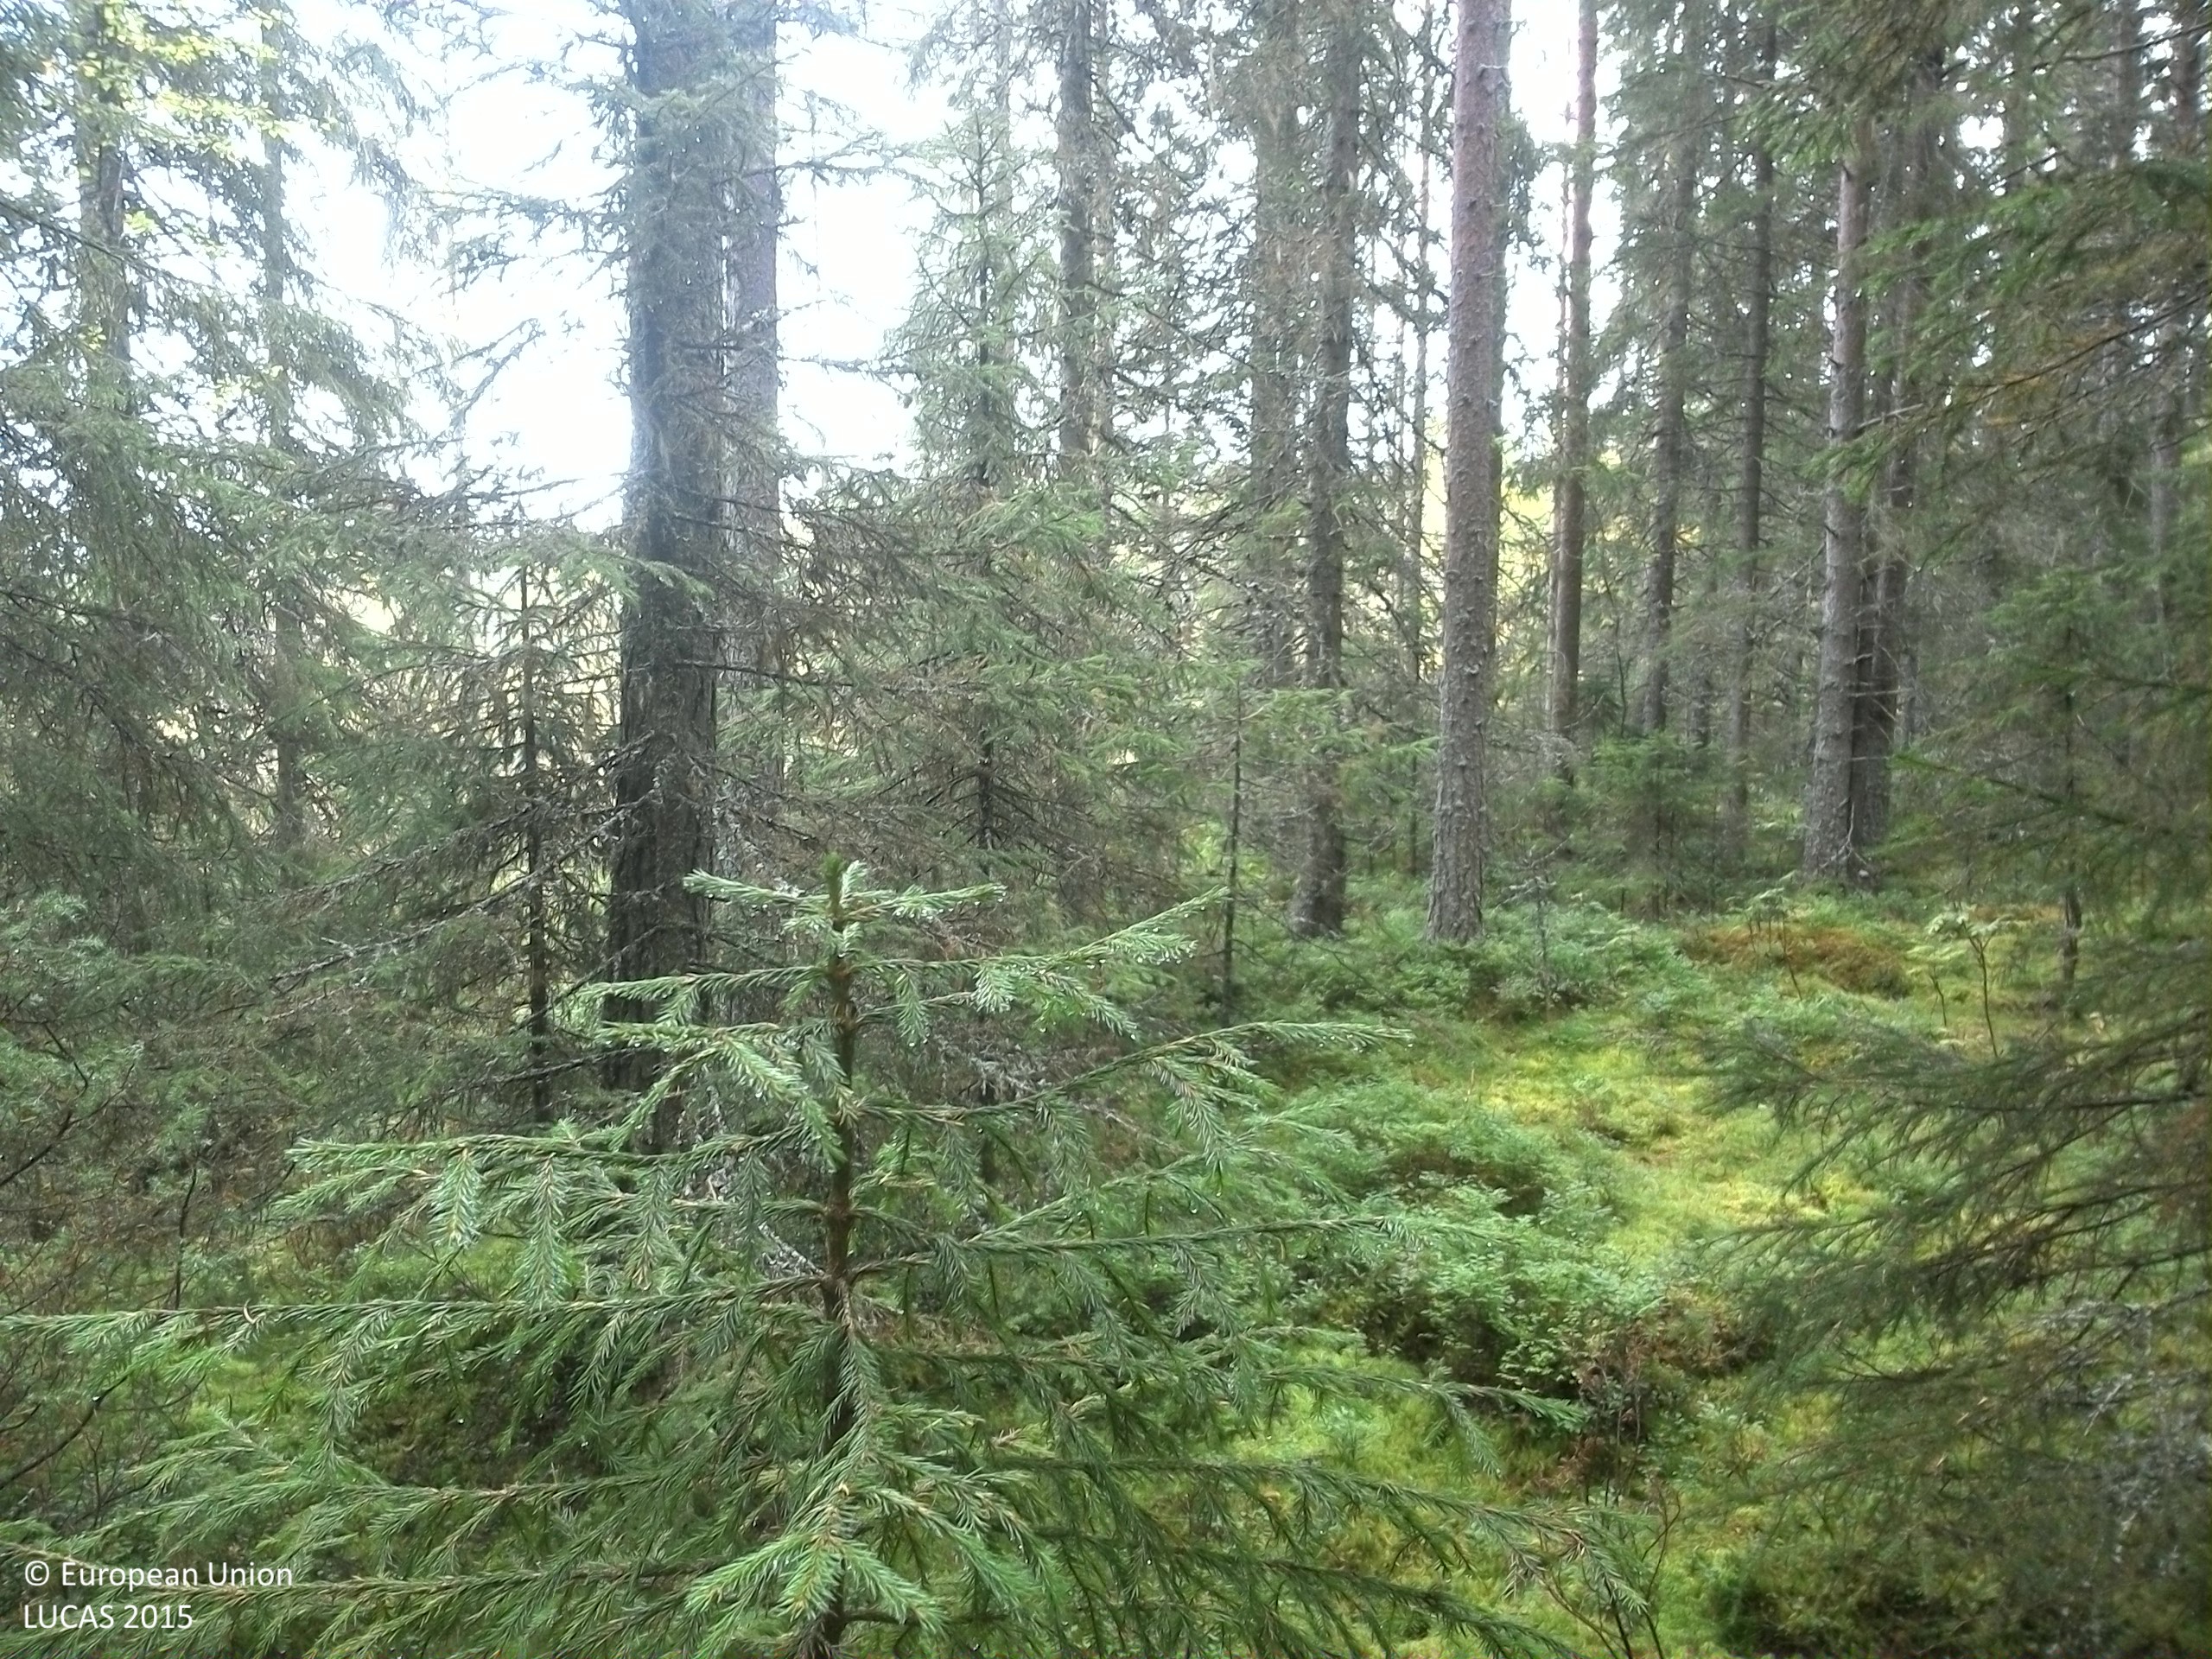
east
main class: Woodland
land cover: Spruce dominated coniferous woodland
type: boreal forest
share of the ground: 50 - 75 %
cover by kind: coniferous forest trees 60 %, shrubs 25 %, lichens and mosses 10 %, broadleaved forest trees 5 %
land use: Forestry
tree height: > 5 m
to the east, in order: Spruce dominated coniferous woodland; Shrubland without tree cover; Electric lines; Shrubland without tree cover; Pine dominated coniferous woodland; Other mixed woodland; Other coniferous woodland; Pine dominated coniferous woodland; Spruce dominated coniferous woodland; Other coniferous woodland; Shrubland without tree cover; Electric lines
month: September
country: SE
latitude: 61.7101
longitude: 15.1848
